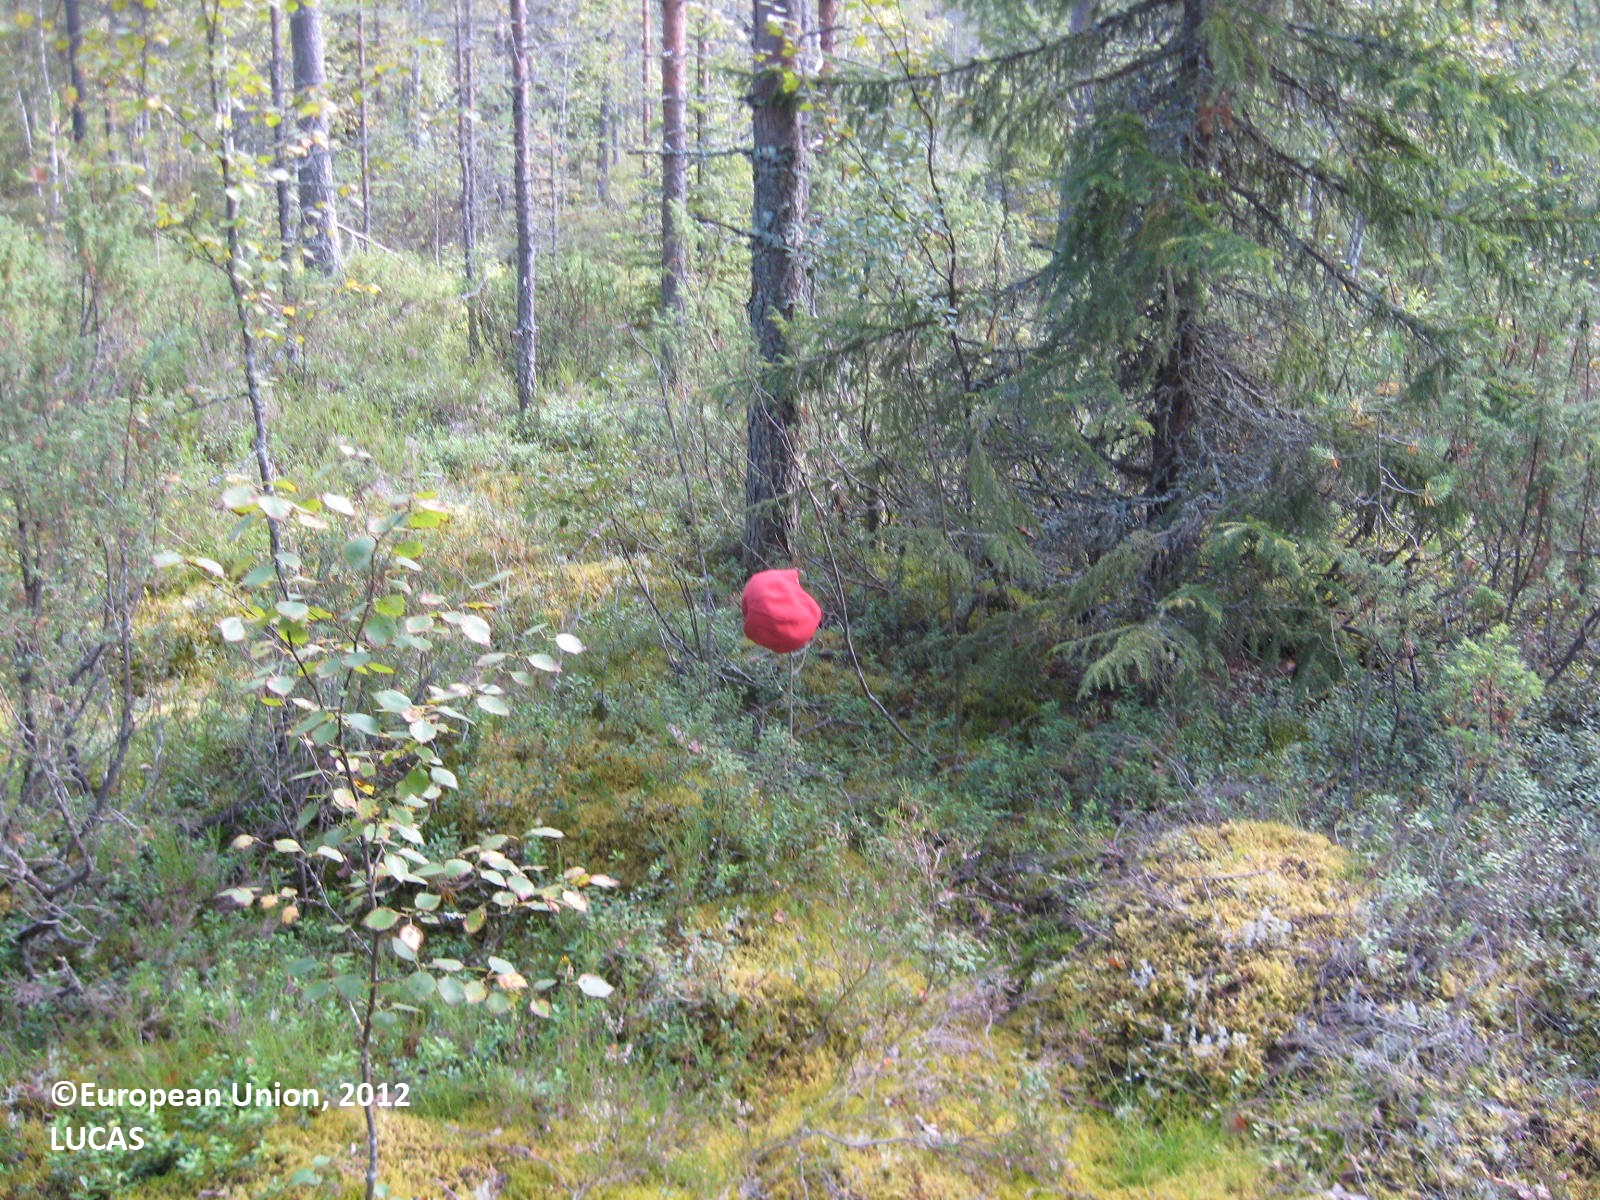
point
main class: Woodland
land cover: Pine dominated coniferous woodland
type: boreal forest
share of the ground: > 75 %
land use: Forestry
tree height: > 5 m
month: August
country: FI
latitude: 63.6925
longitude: 29.4980
